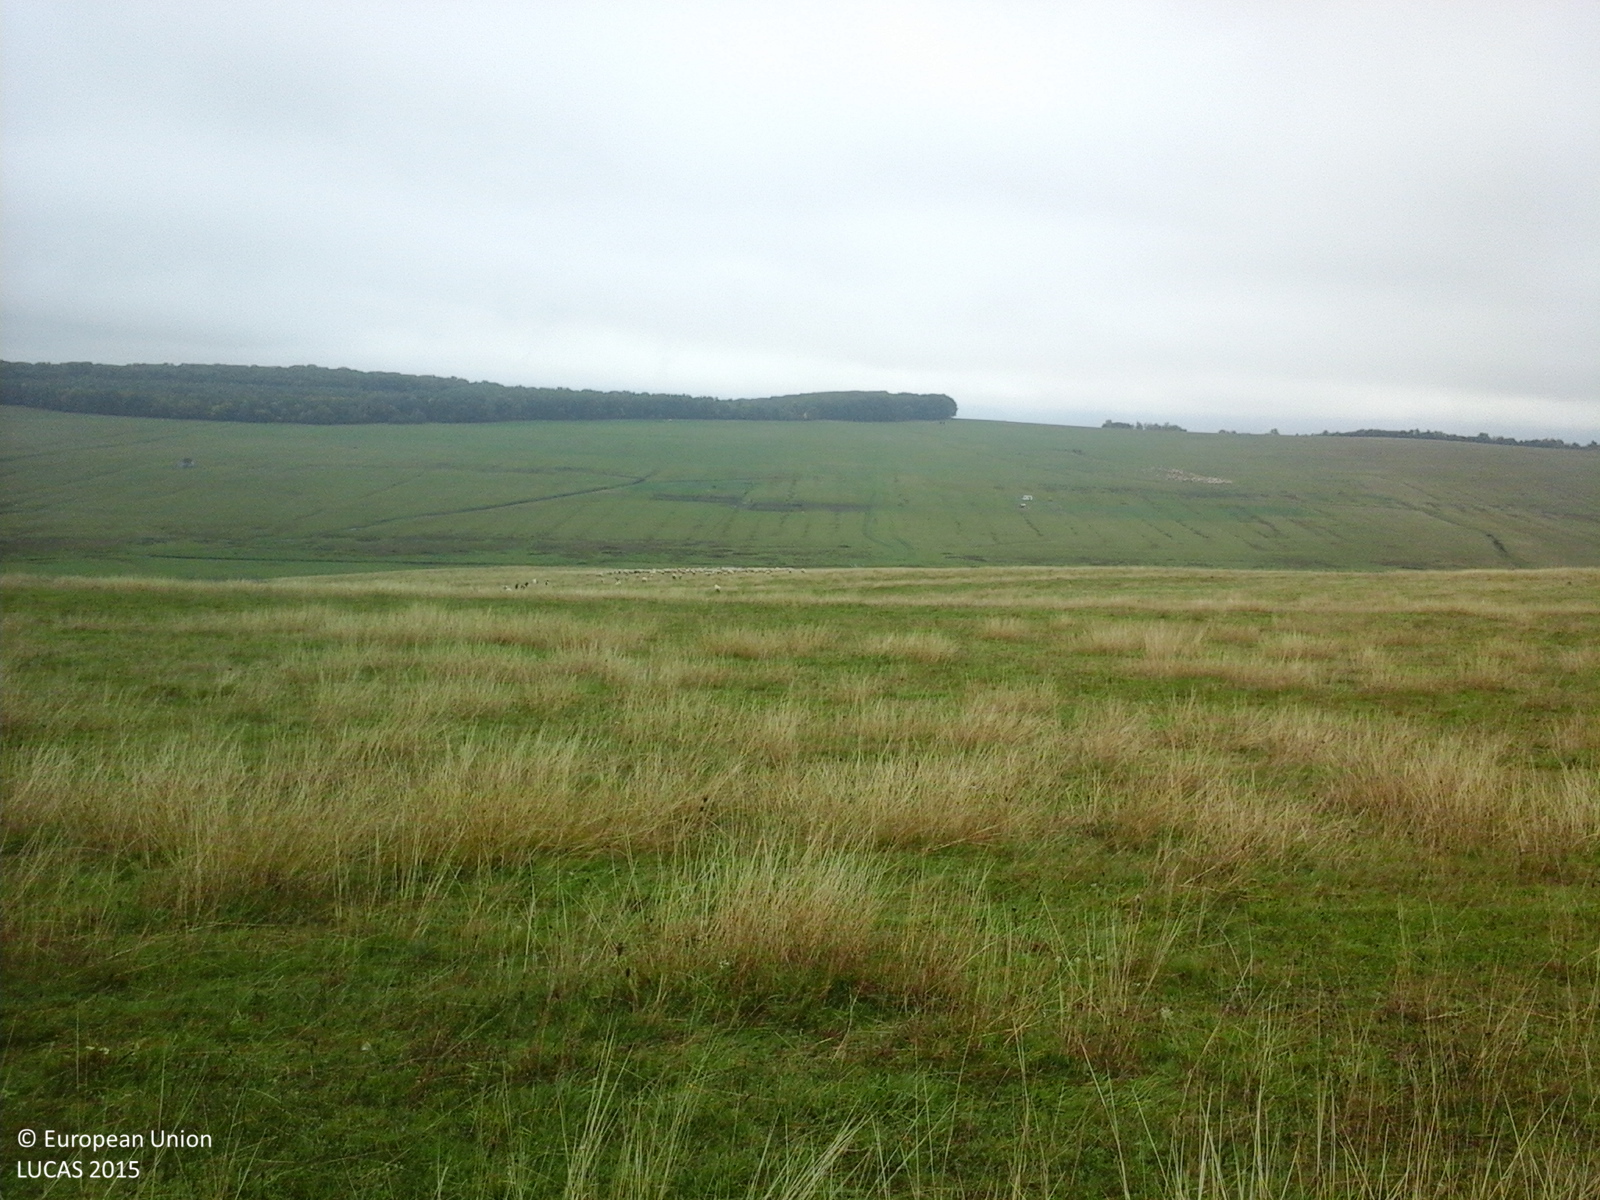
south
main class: Grassland
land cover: Grassland without tree/shrub cover
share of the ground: > 75 %
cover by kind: herbaceous plants 100 %
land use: Agriculture (excluding fallow land and kitchen gardens)
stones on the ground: < 10 %
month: October
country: RO
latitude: 45.8075
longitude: 24.0082
